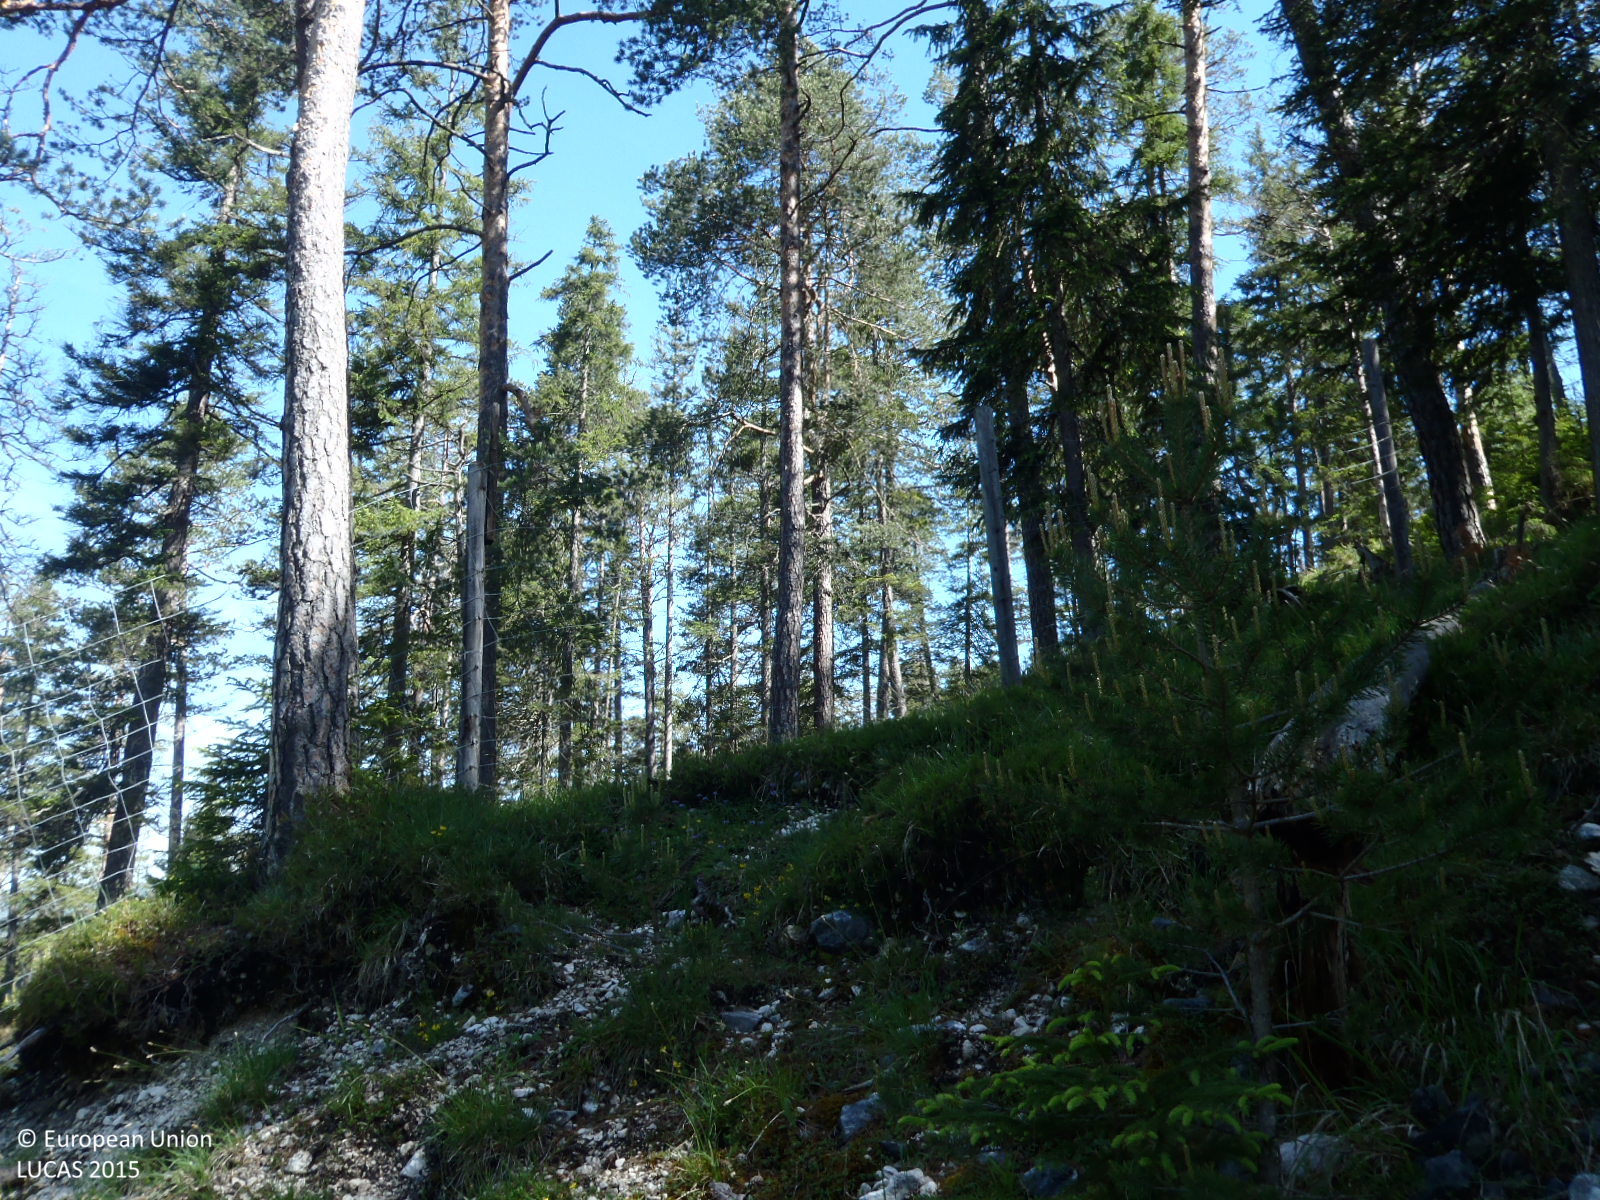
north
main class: Woodland
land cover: Pine dominated coniferous woodland
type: alpine coniferous forest
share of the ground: > 75 %
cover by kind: coniferous forest trees 90 %, herbaceous plants 5 %, unconsolidated bare surface 5 %
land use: Forestry
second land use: Agriculture (excluding fallow land and kitchen gardens)
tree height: > 5 m
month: May
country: AT
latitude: 47.5262
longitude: 11.7120
